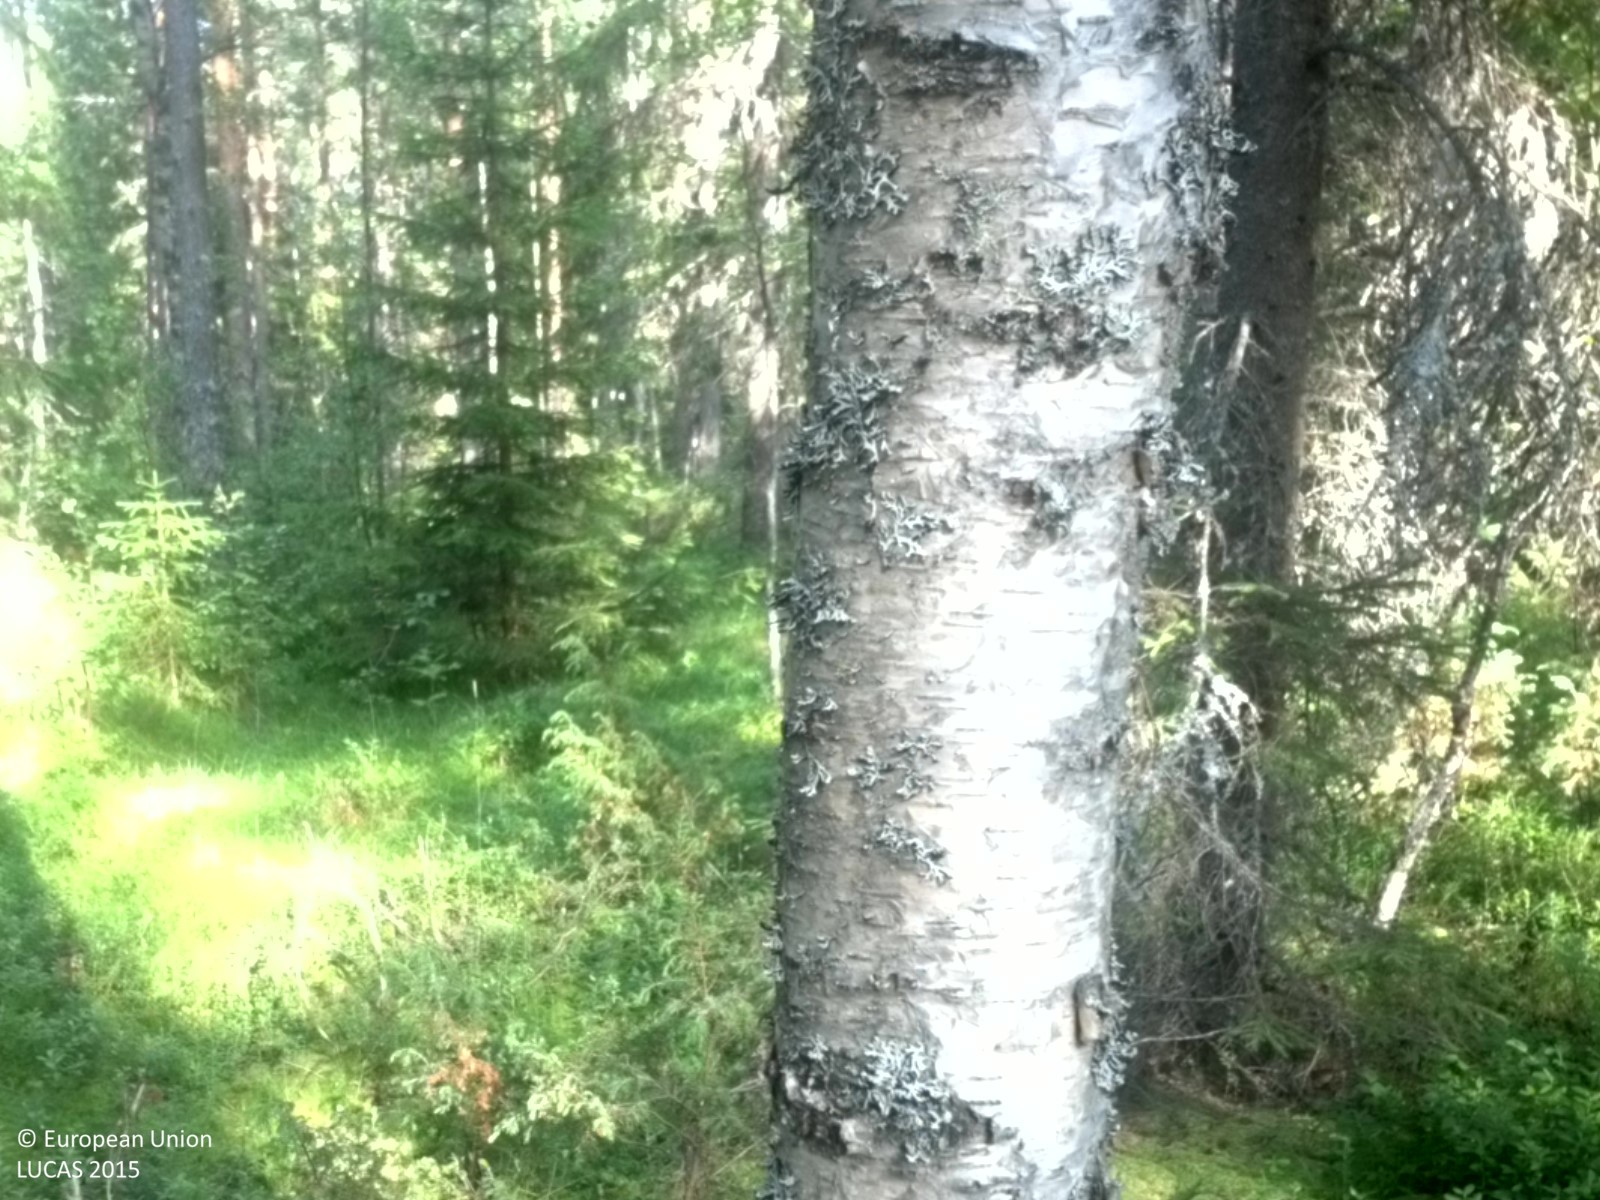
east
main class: Woodland
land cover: Other mixed woodland
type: boreal forest
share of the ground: 50 - 75 %
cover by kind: coniferous forest trees 40 %, herbaceous plants 30 %, broadleaved forest trees 20 %, shrubs 10 %
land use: Forestry
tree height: > 5 m
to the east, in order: Other mixed woodland; Spruce dominated mixed woodland; Other coniferous woodland; Pine dominated coniferous woodland; Other coniferous woodland; Pine dominated mixed woodland
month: July
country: SE
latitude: 63.6868
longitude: 19.9088
